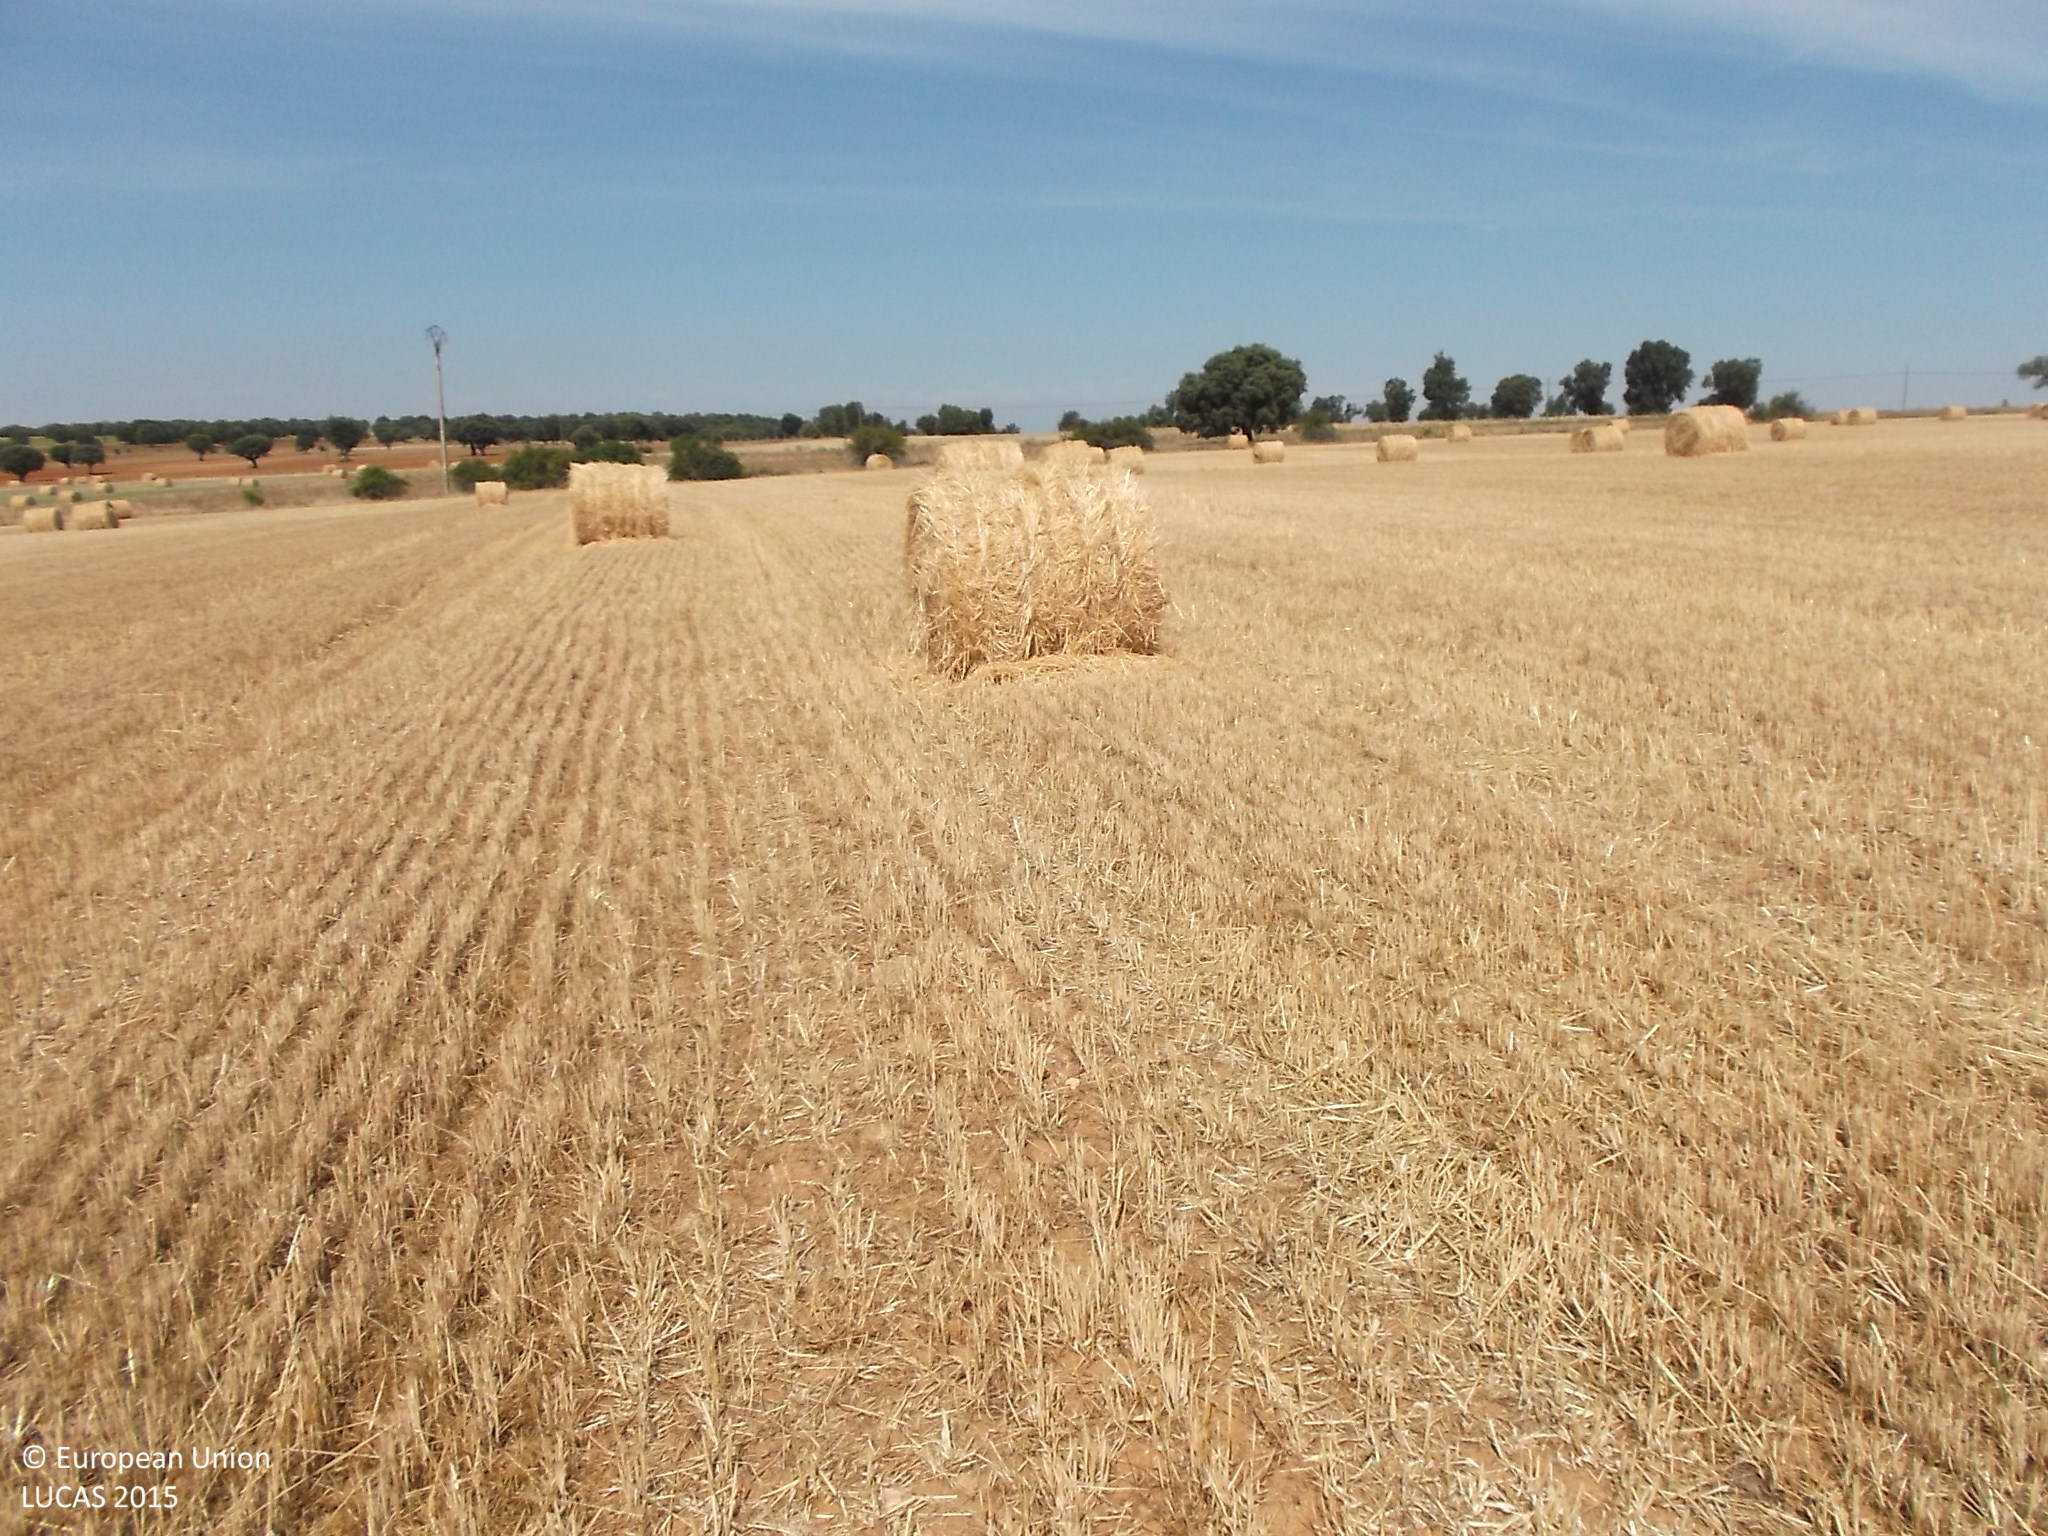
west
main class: Cropland
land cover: Mixed cereals for fodder
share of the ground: < 10 %
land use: Agriculture (excluding fallow land and kitchen gardens)
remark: Harvested field
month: June
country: ES
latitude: 41.2095
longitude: -5.9850
